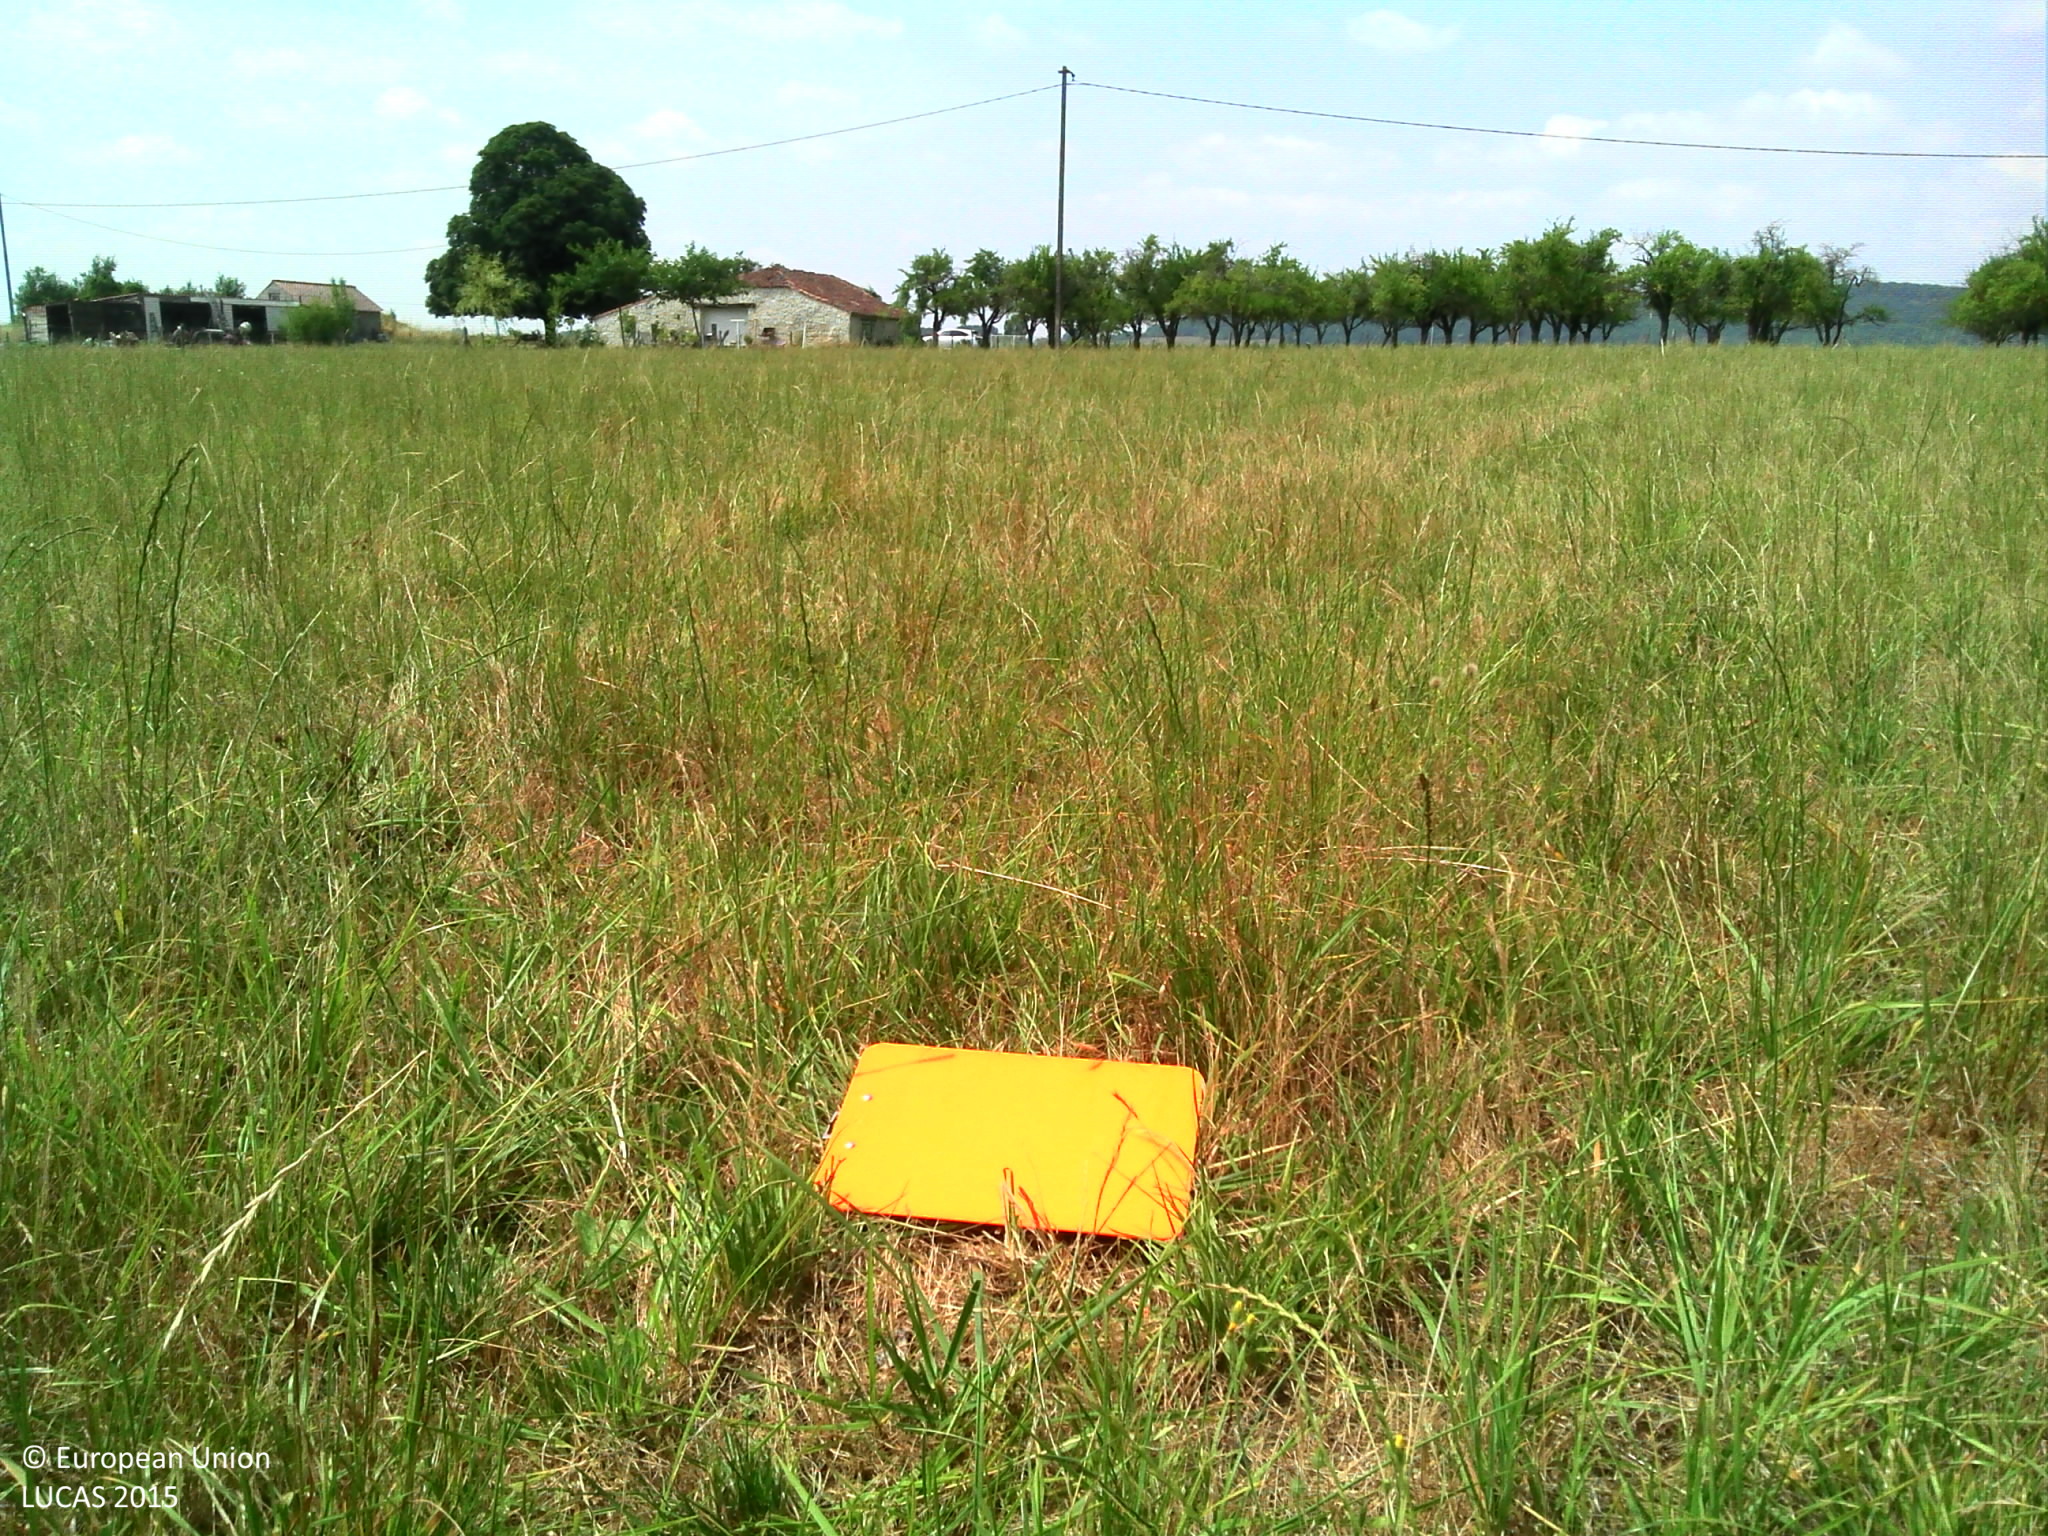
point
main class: Grassland
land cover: Grassland without tree/shrub cover
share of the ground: > 75 %
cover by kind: herbaceous plants 100 %
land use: Agriculture (excluding fallow land and kitchen gardens)
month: July
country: FR
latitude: 44.4185
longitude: 0.8643
